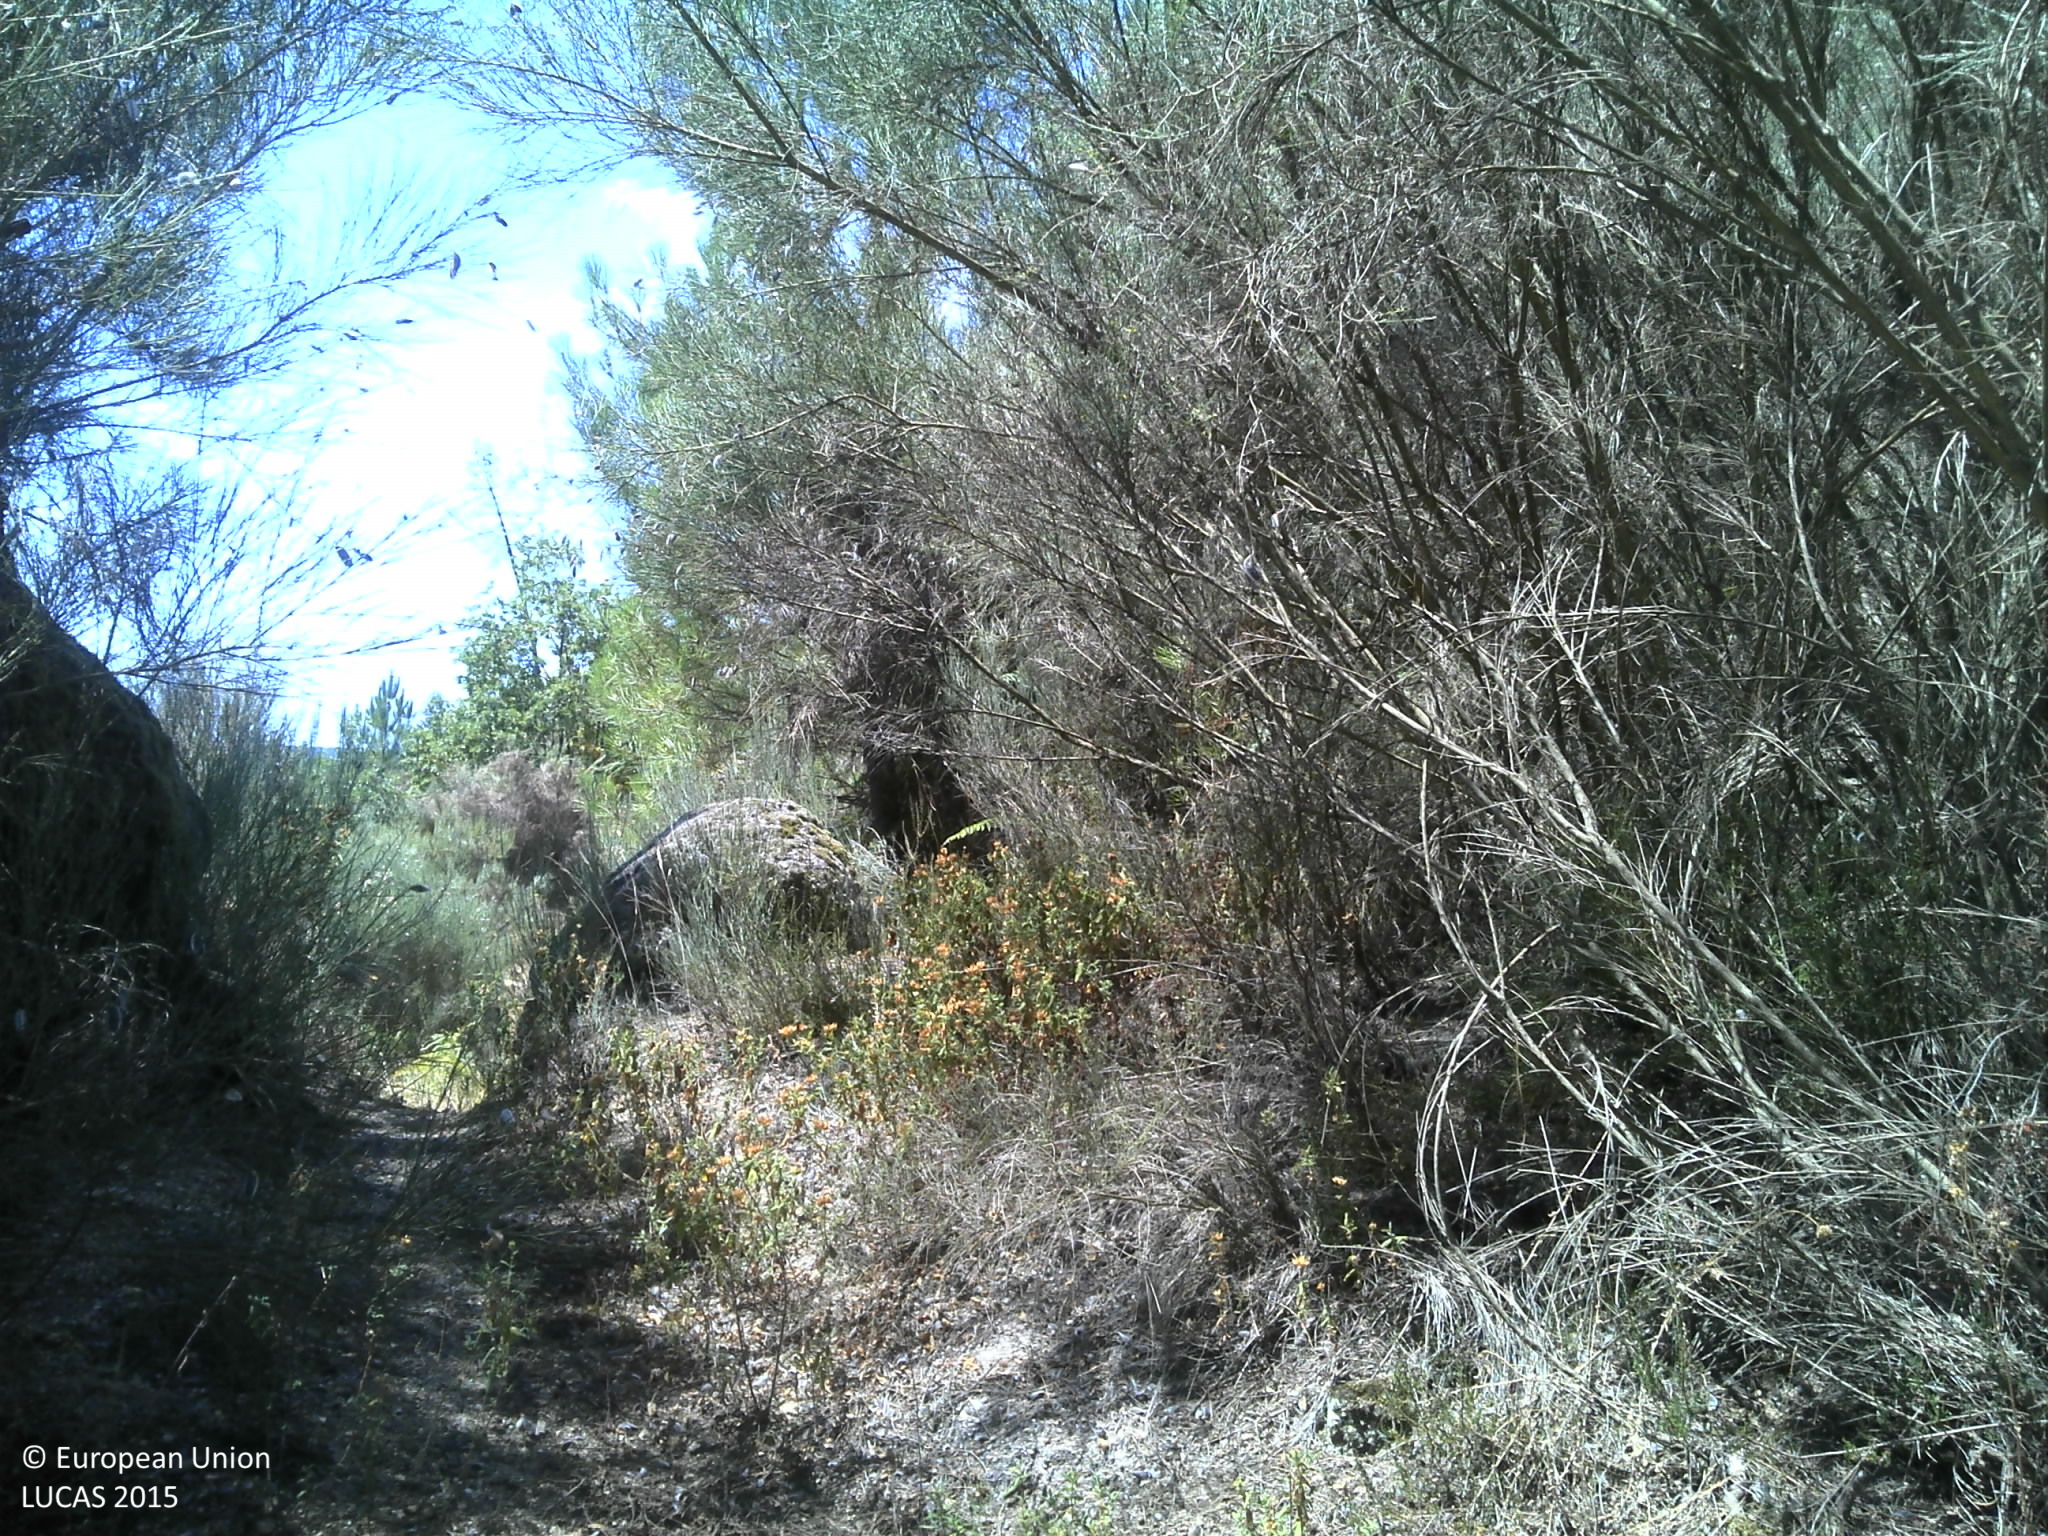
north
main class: Shrubland
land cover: Shrubland with sparse tree cover
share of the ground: 50 - 75 %
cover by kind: shrubs 75 %, unconsolidated bare surface 20 %, coniferous forest trees 5 %
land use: Abandoned areas
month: July
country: PT
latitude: 40.3751
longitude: -7.7226
